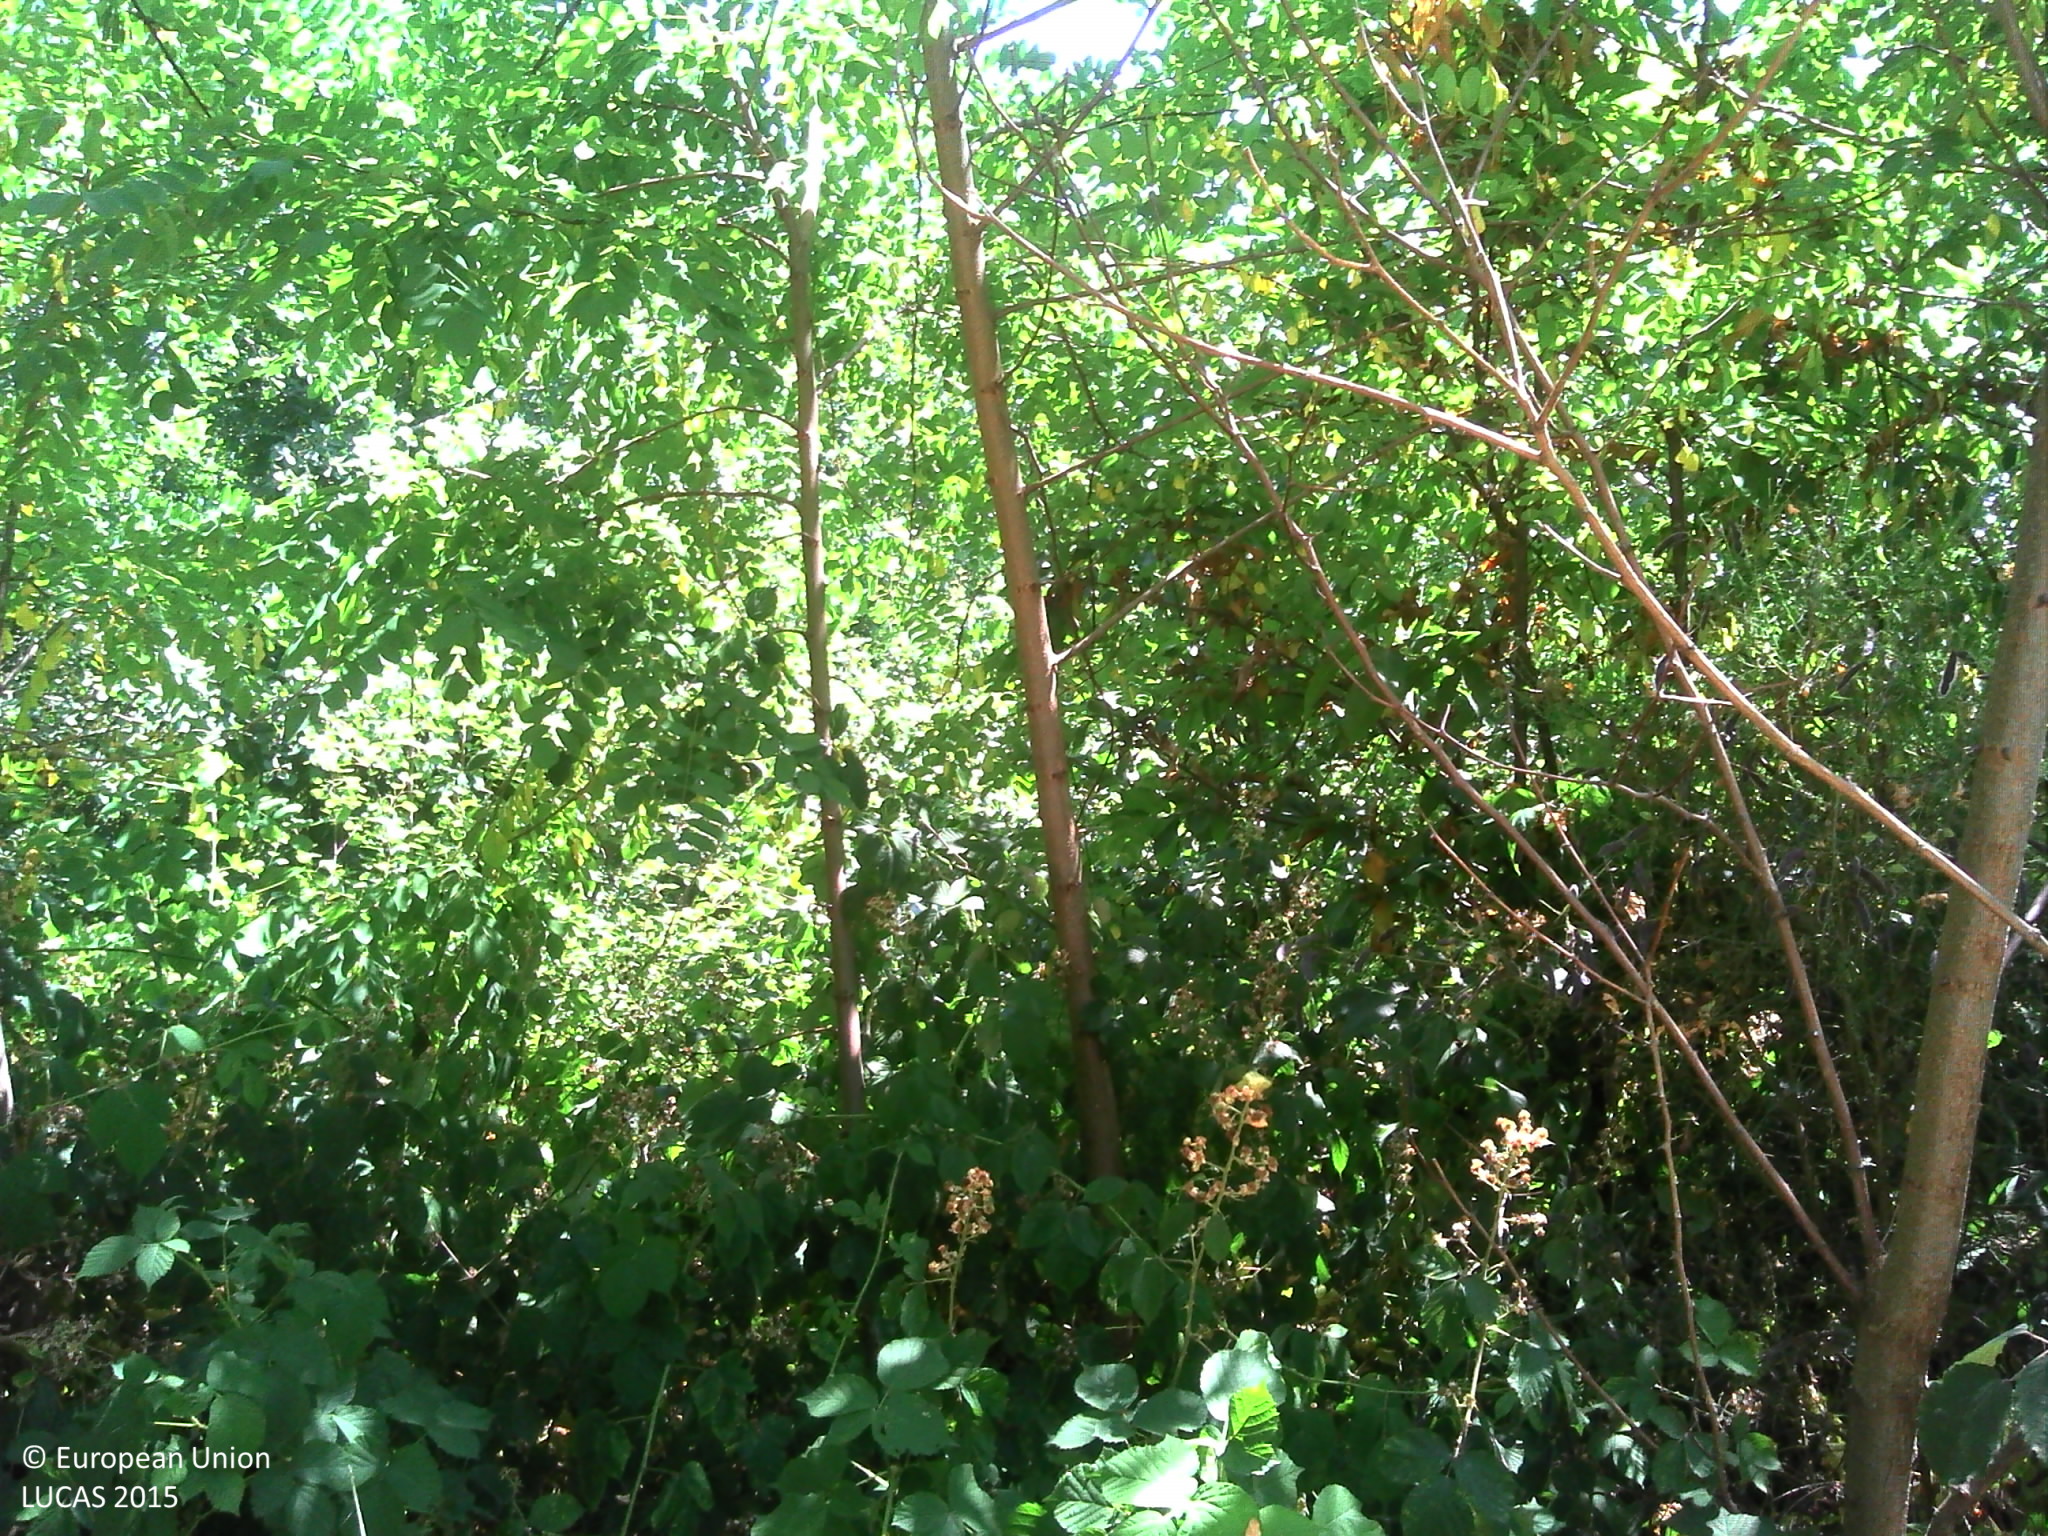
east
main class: Woodland
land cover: Broadleaved woodland
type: mesophytic deciduous forest
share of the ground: > 75 %
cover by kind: broadleaved forest trees 100 %
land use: Forestry
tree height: > 5 m
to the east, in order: Broadleaved woodland; Shrubland with sparse tree cover; Broadleaved woodland; Artificial constructions in urban areas; Broadleaved woodland; Grassland without tree/shrub cover
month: July
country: FR
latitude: 45.1598
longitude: 5.1839
